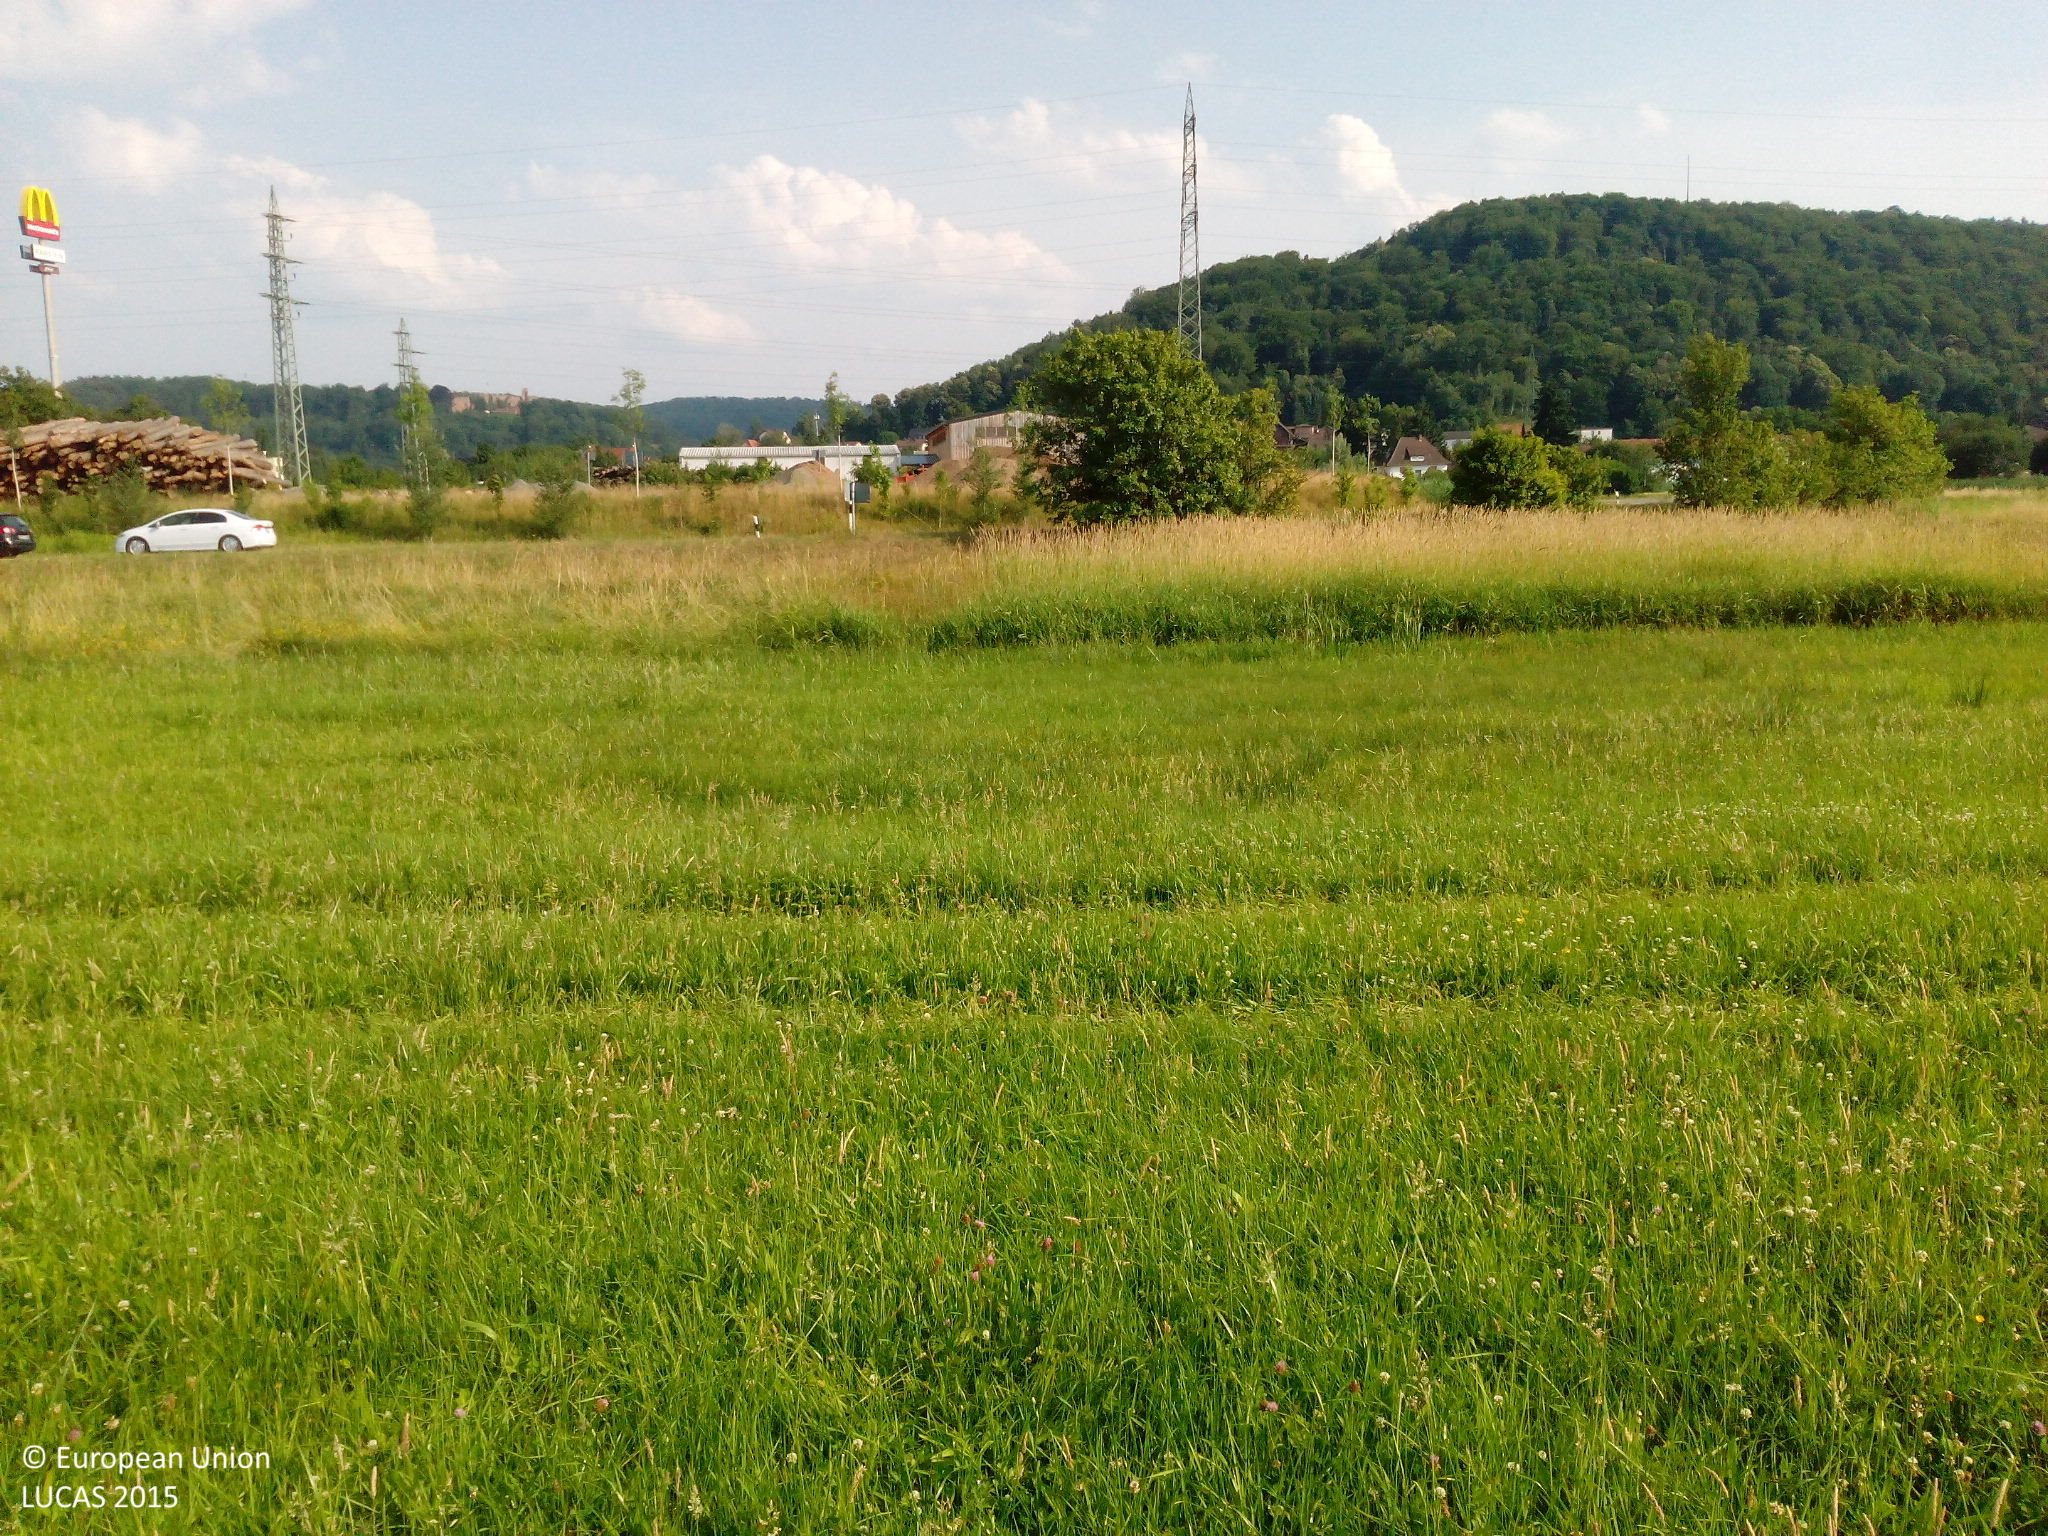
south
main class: Grassland
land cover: Grassland without tree/shrub cover
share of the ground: > 75 %
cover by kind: herbaceous plants 90 %, unconsolidated bare surface 10 %
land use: Agriculture (excluding fallow land and kitchen gardens)
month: July
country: DE
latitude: 49.4205
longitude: 7.5604
